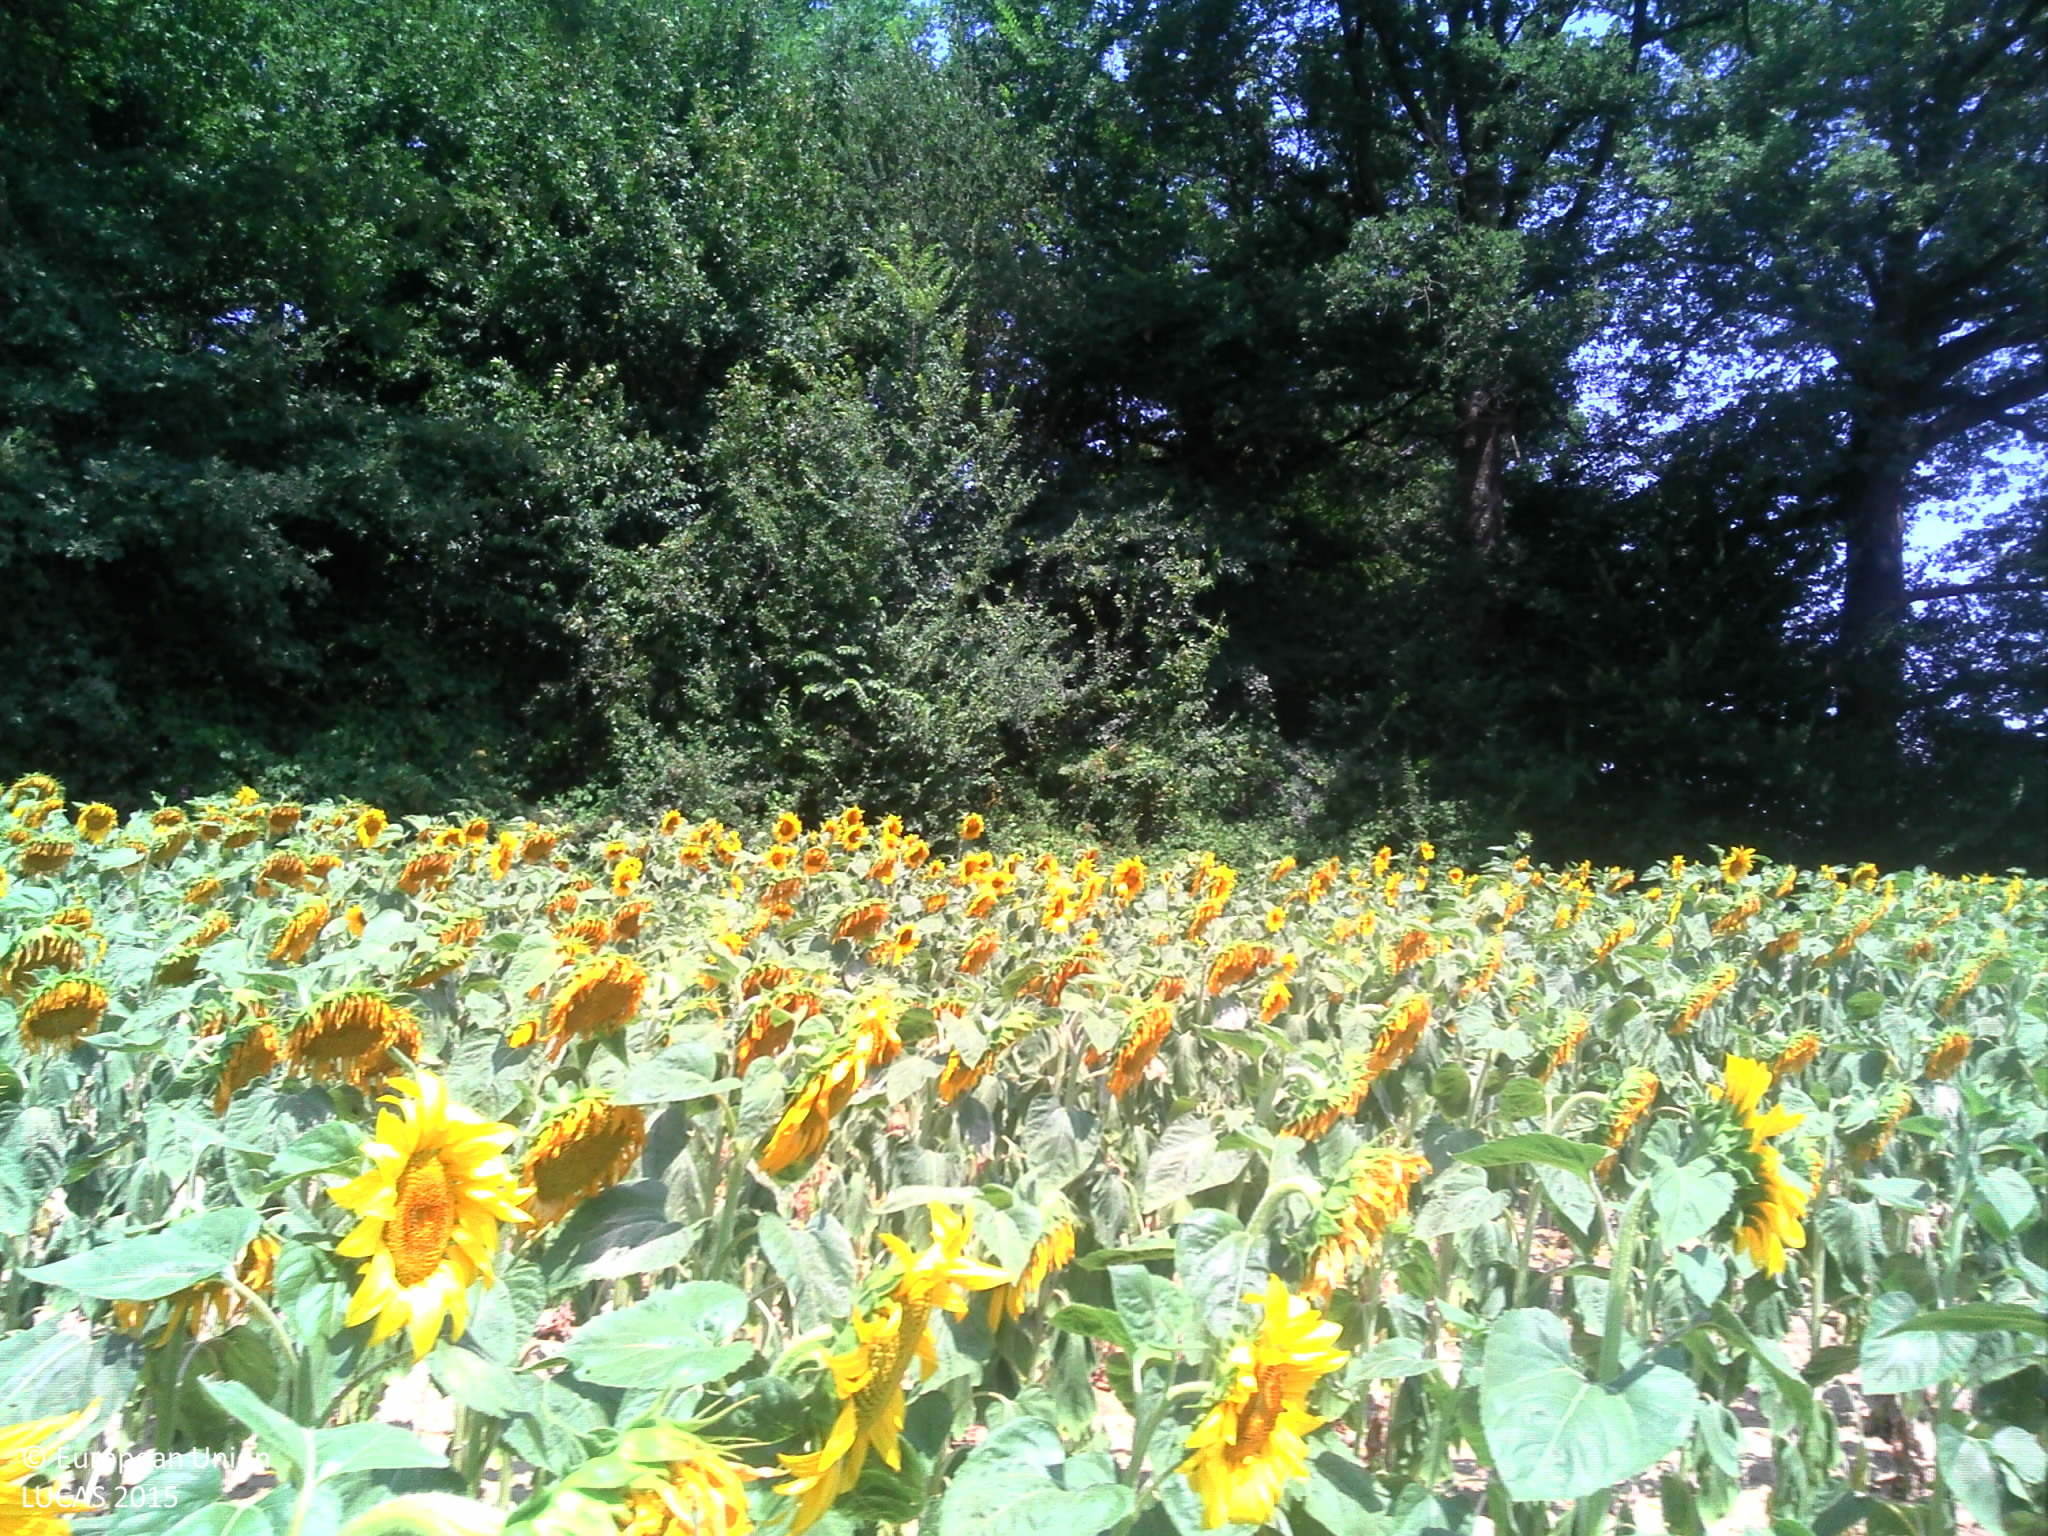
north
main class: Cropland
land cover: Sunflower
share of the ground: > 75 %
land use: Agriculture (excluding fallow land and kitchen gardens)
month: July
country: FR
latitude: 43.3227
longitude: 0.9877
